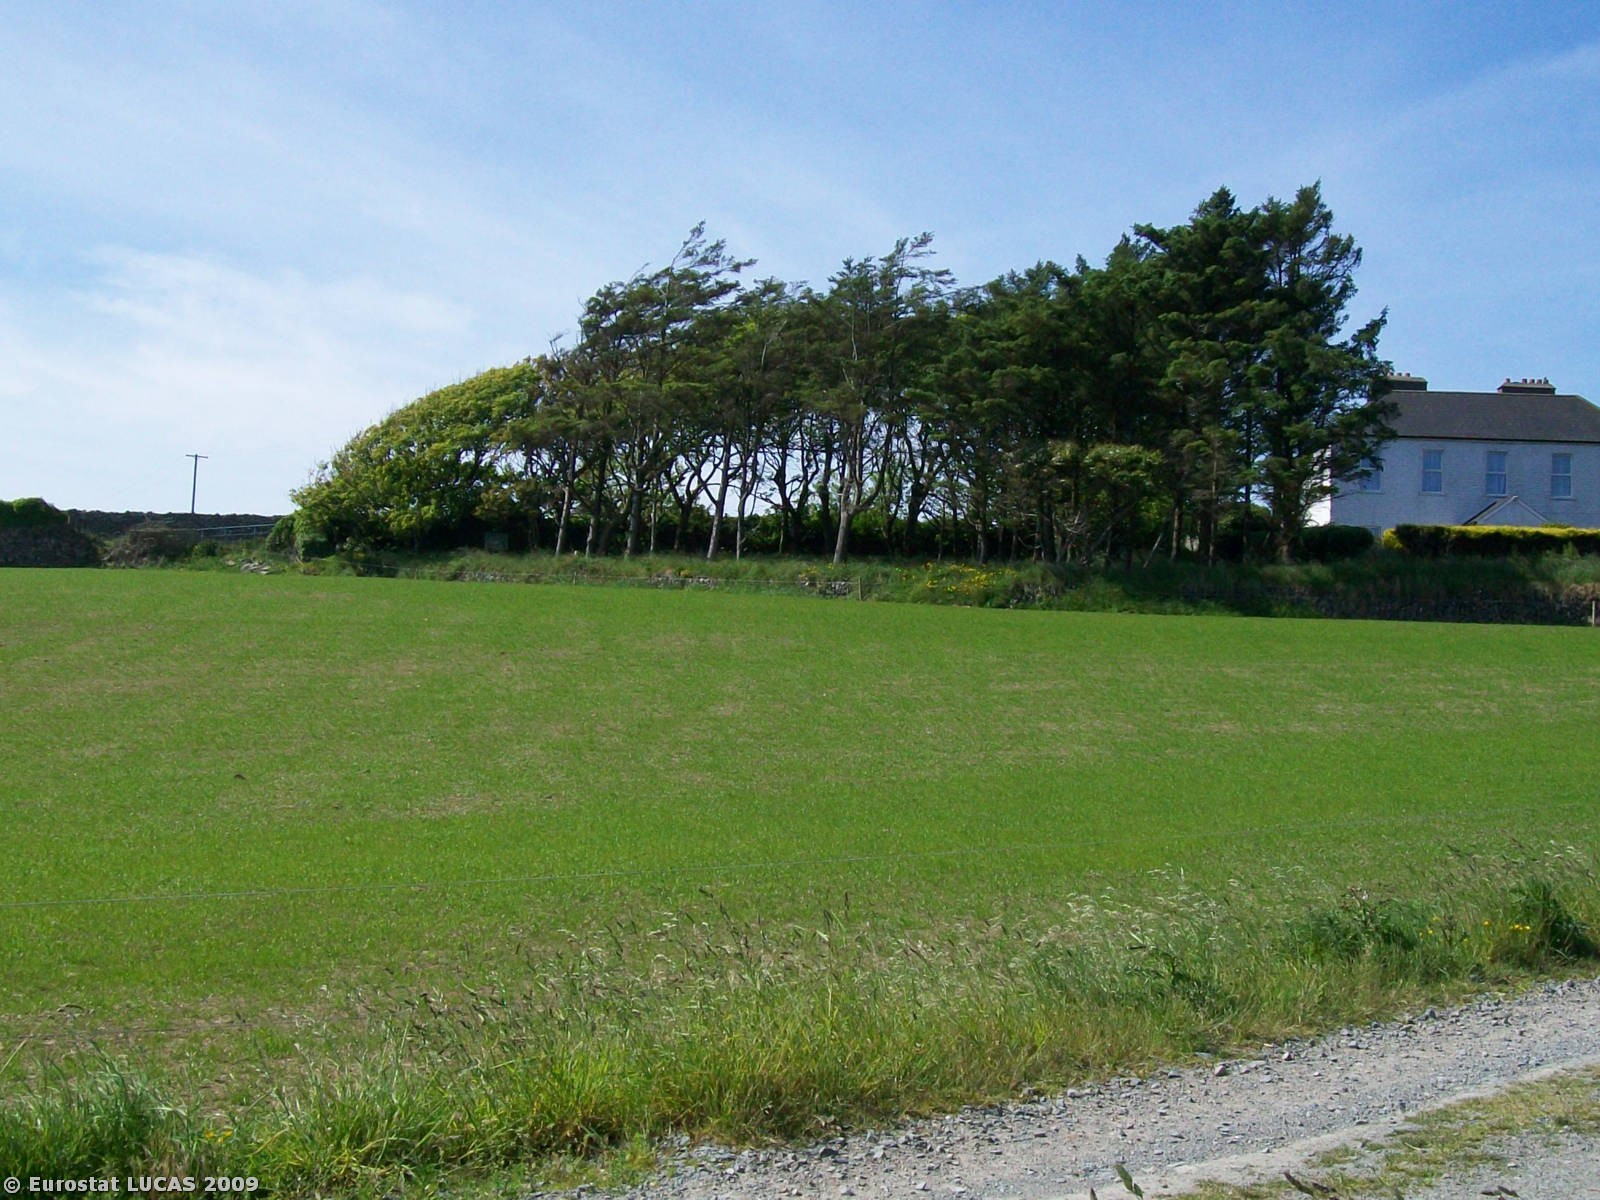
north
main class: Grassland
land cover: Grassland without tree/shrub cover
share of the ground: > 75 %
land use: Agriculture (excluding fallow land and kitchen gardens)
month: July
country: IE
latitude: 52.5262
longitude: -7.6907
